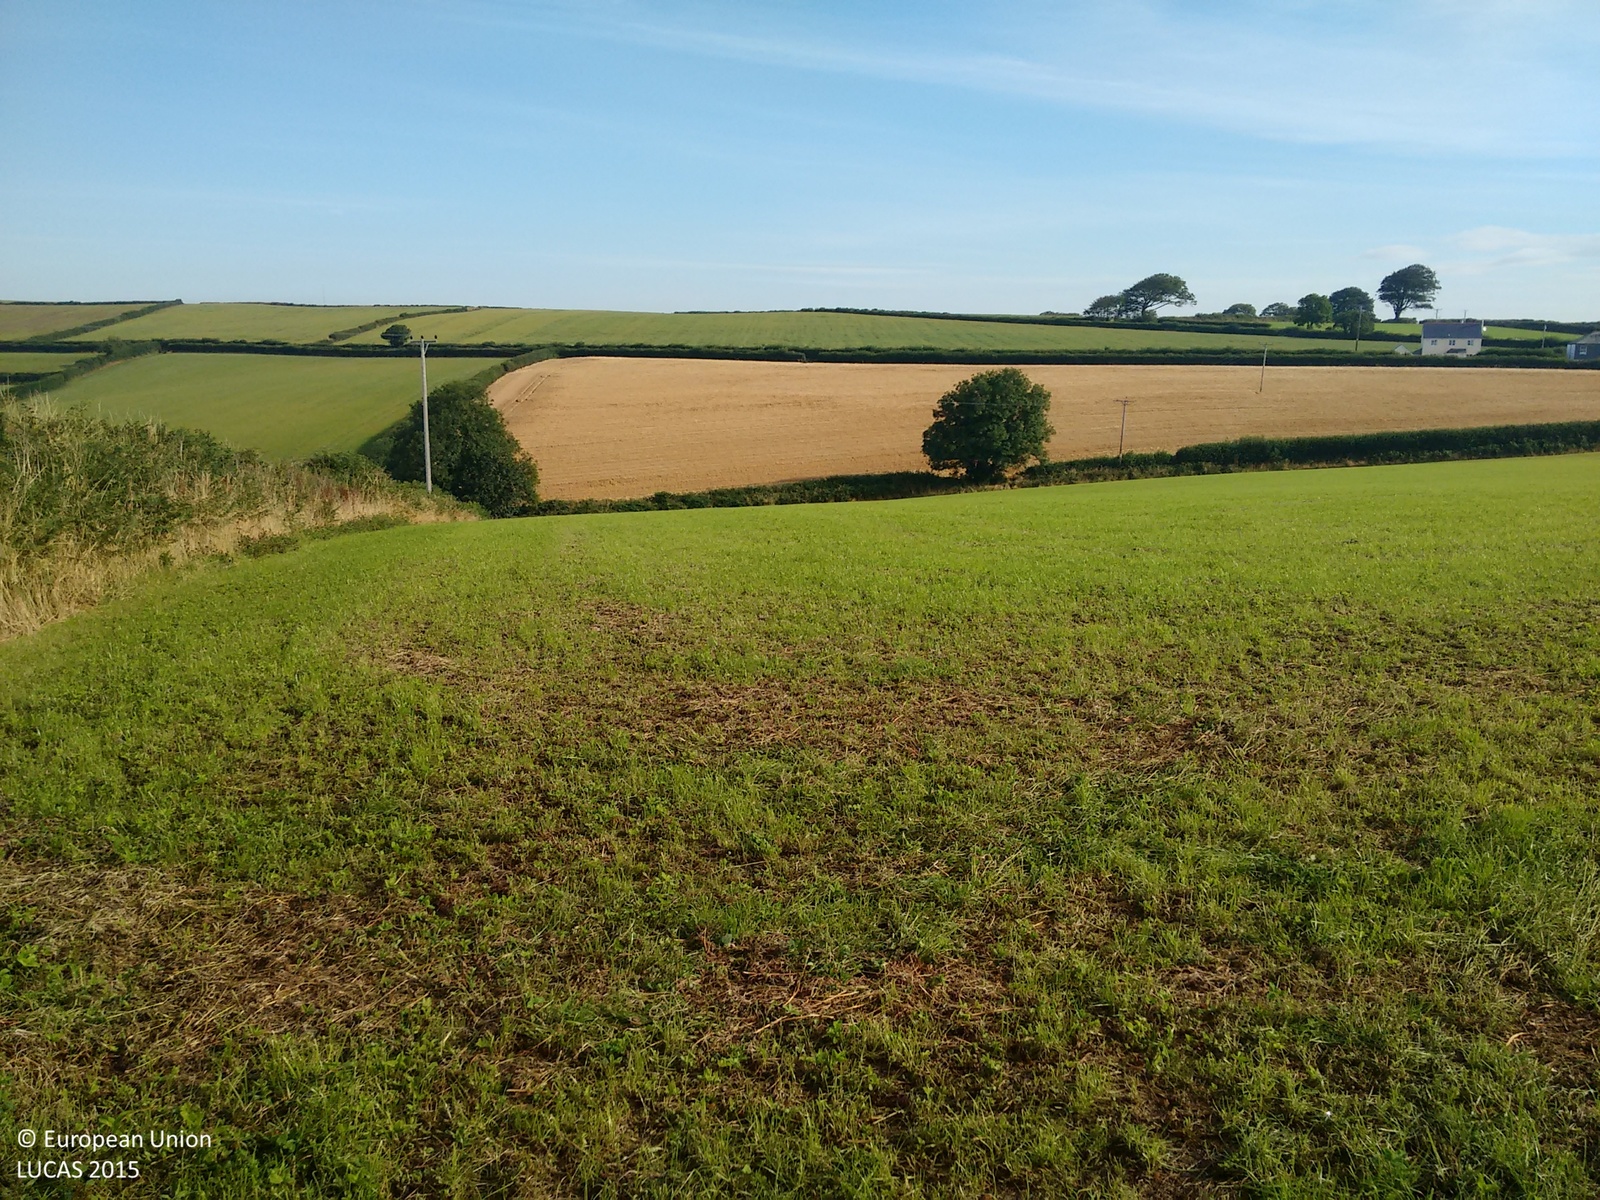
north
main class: Grassland
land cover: Grassland without tree/shrub cover
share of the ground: > 75 %
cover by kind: herbaceous plants 100 %
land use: Agriculture (excluding fallow land and kitchen gardens)
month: August
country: GB
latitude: 50.4343
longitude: -4.3918
